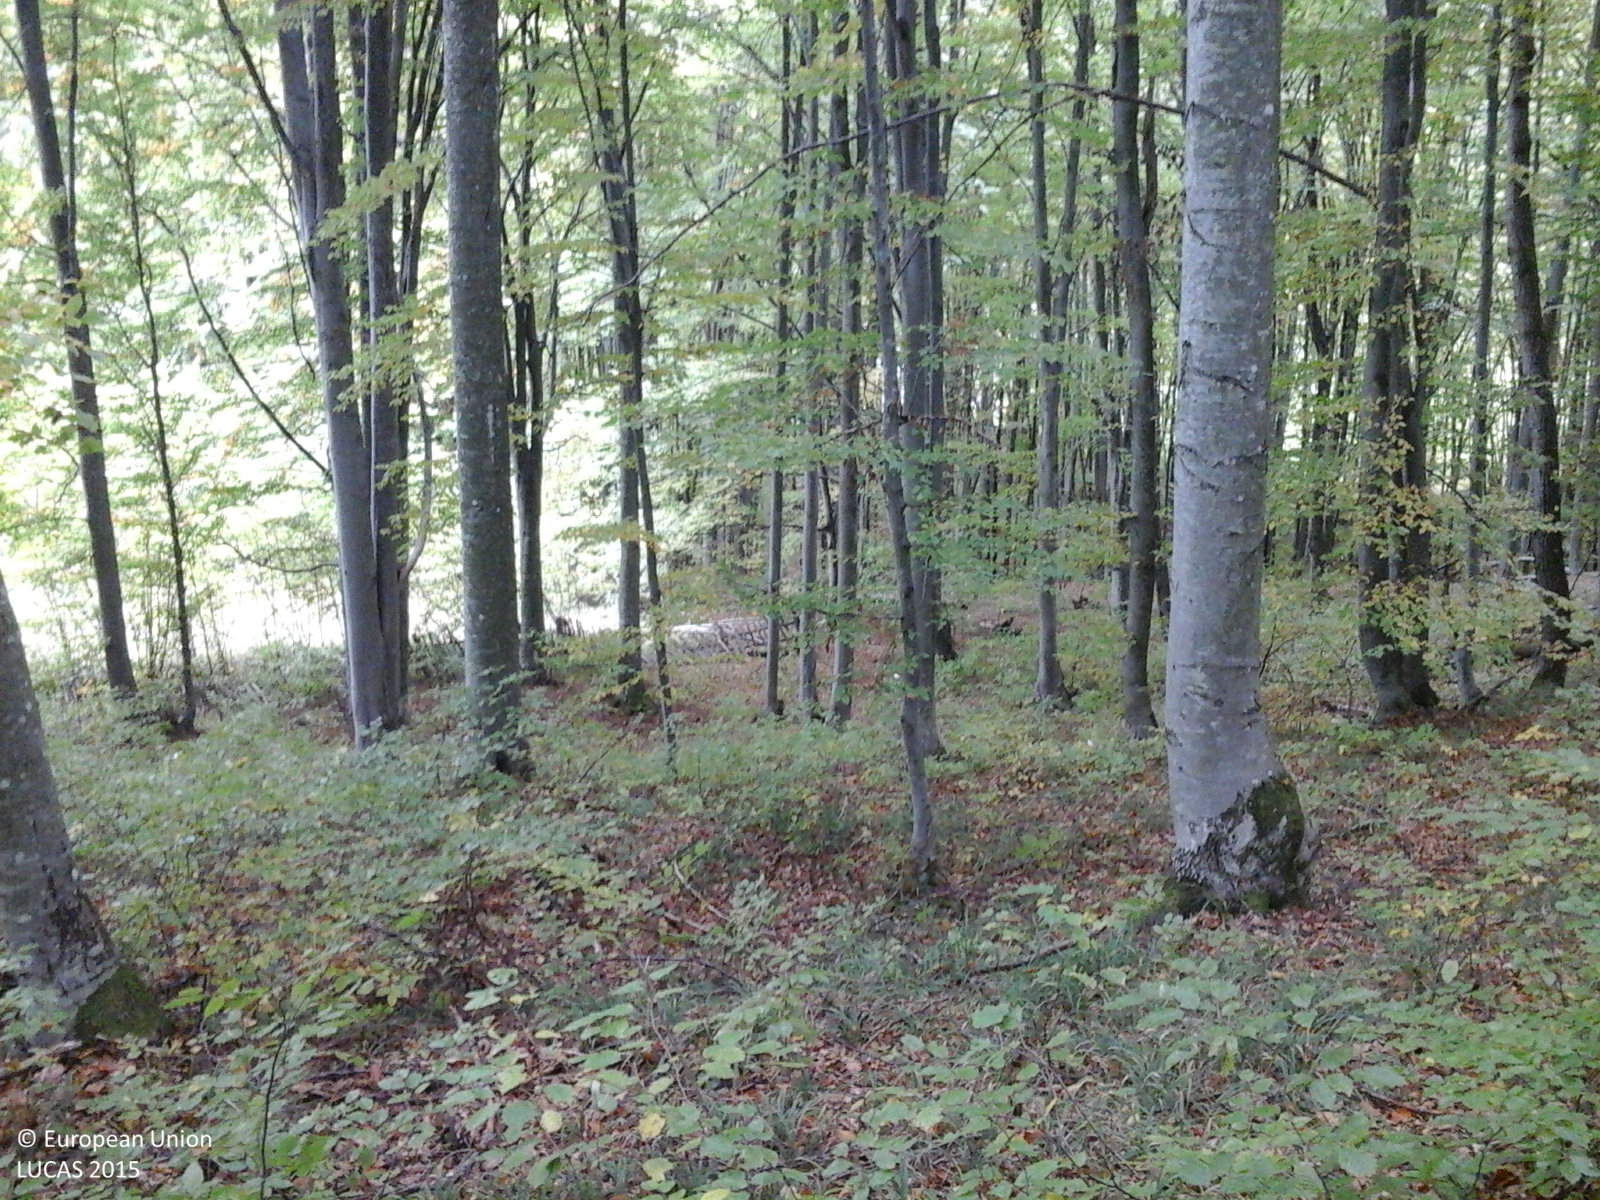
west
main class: Woodland
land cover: Broadleaved woodland
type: beech forest
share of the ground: > 75 %
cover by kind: broadleaved forest trees 100 %
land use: Forestry
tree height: > 5 m
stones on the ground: 10 - 25 %
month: October
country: RO
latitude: 46.6540
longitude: 25.0350
